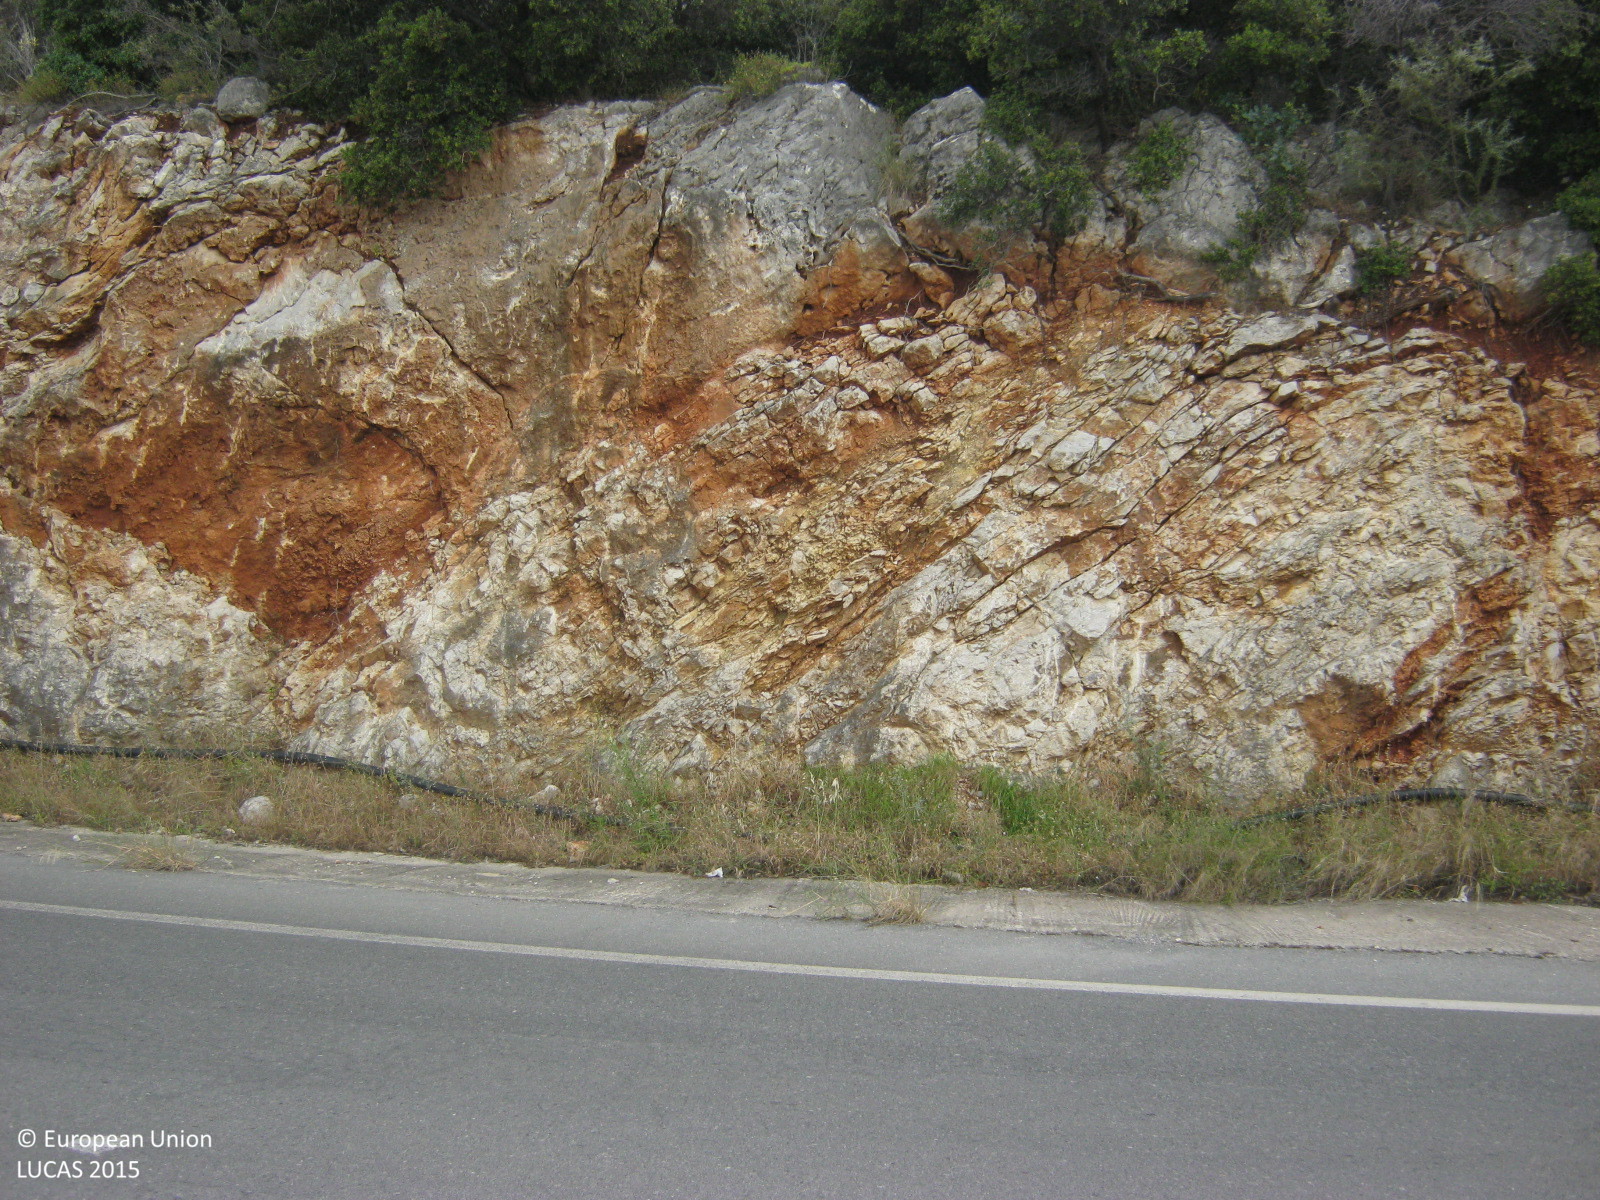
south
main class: Shrubland
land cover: Shrubland with sparse tree cover
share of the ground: > 75 %
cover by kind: shrubs 95 %, broadleaved forest trees 5 %
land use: Semi-natural and natural areas not in use
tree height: < 5 m
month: June
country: GR
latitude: 37.5107
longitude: 22.7370
